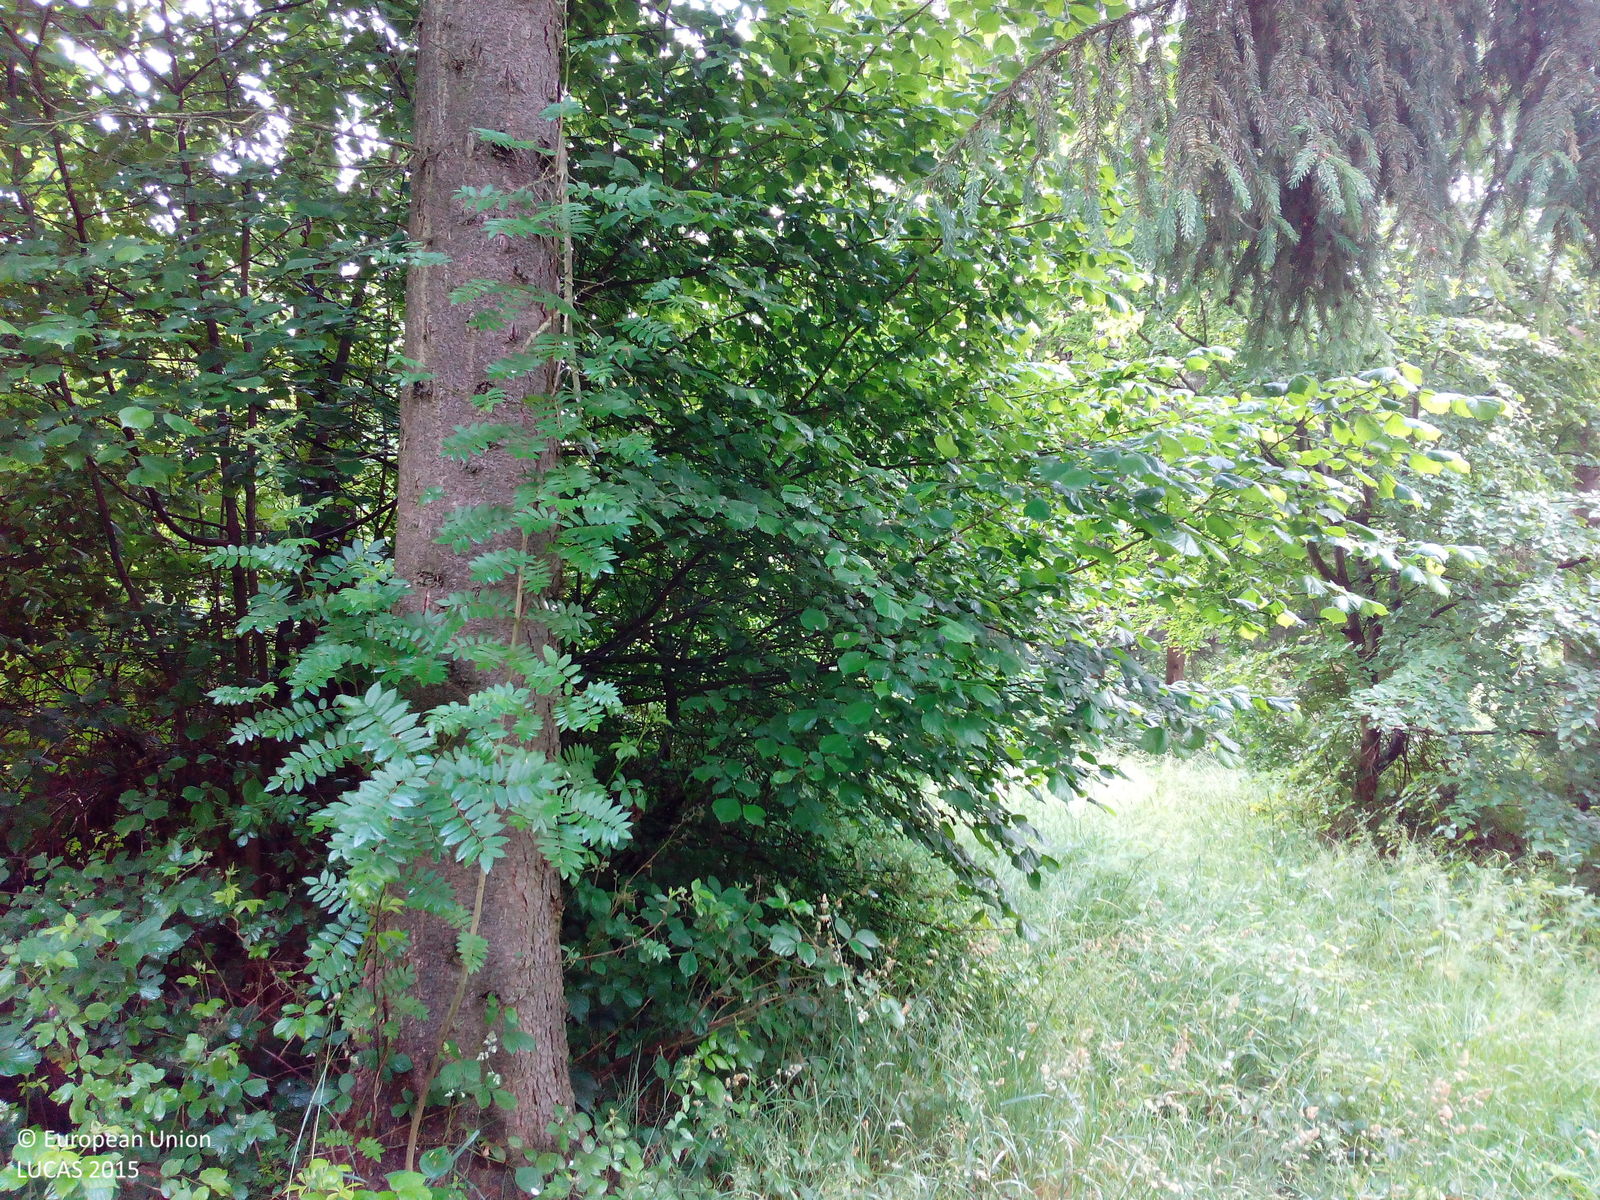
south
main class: Woodland
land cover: Spruce dominated coniferous woodland
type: hemiboreal forest and nemoral coniferous forest and mixed broadleaved-coniferous forest
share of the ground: > 75 %
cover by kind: coniferous forest trees 90 %, broadleaved forest trees 10 %
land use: Forestry
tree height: > 5 m
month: June
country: DE
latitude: 51.9100
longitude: 9.8692
